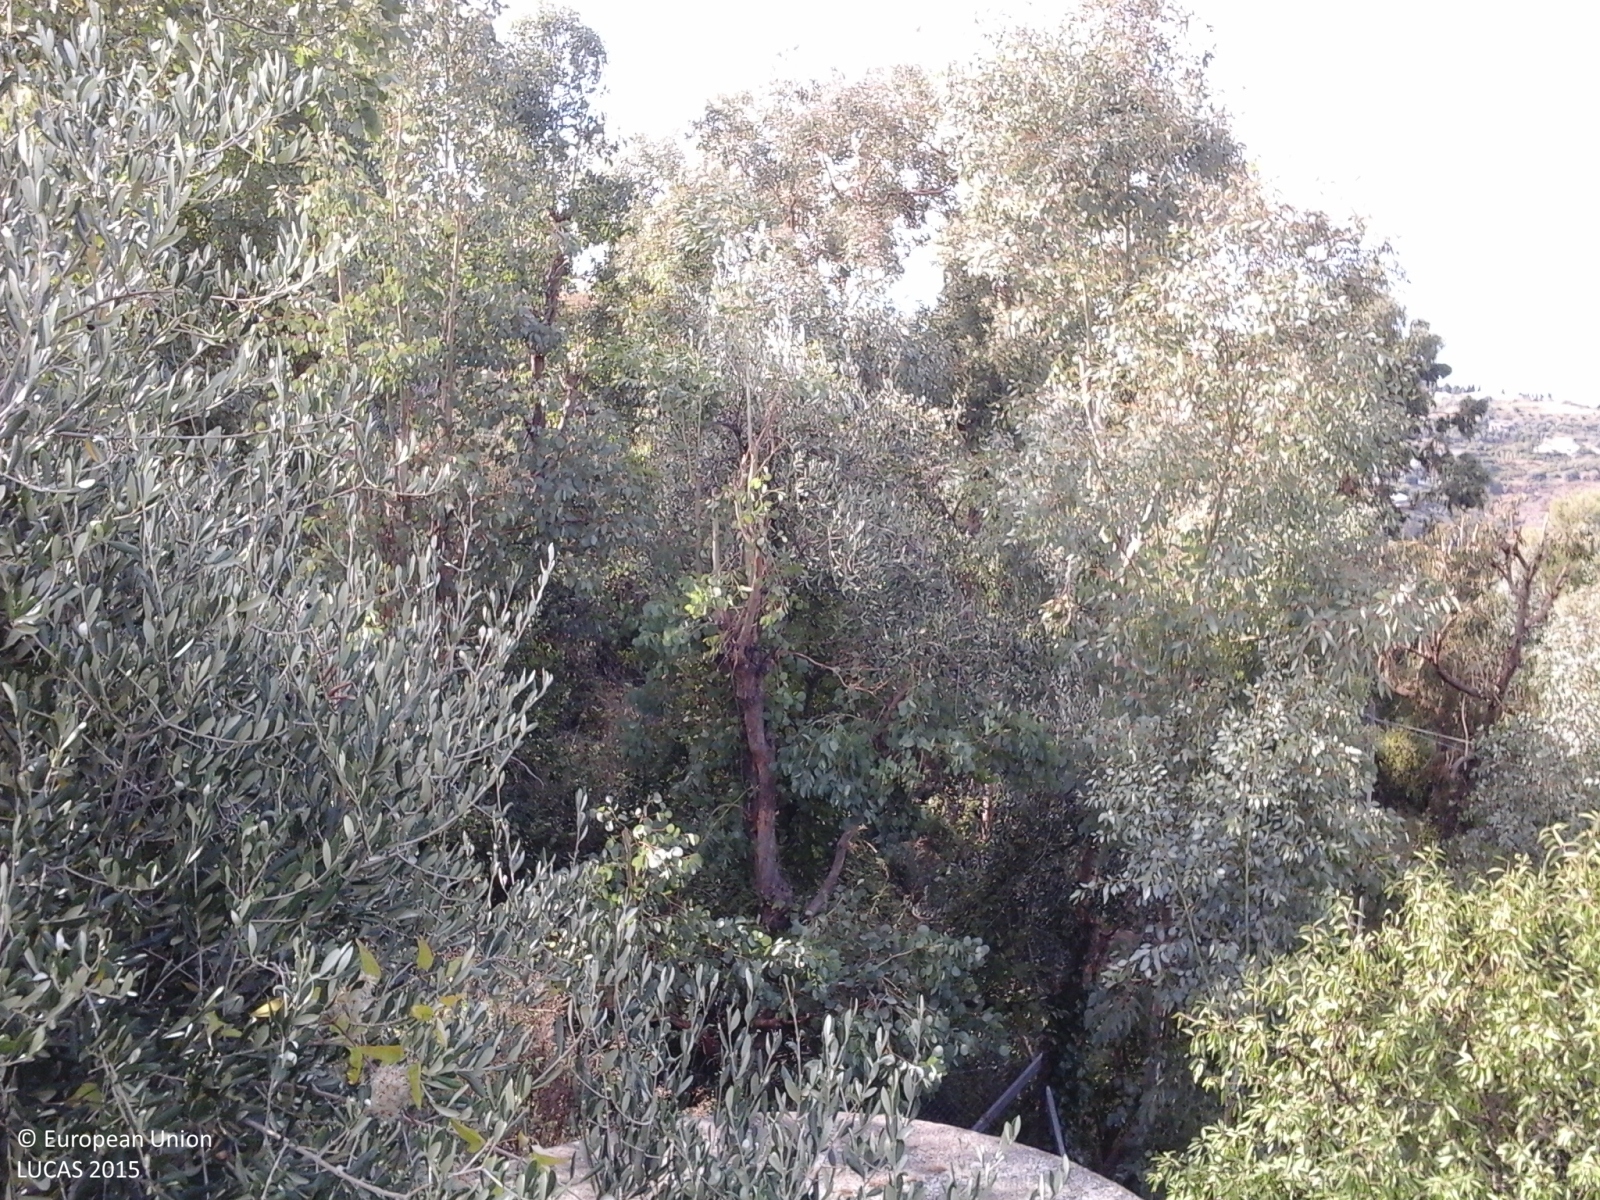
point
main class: Woodland
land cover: Broadleaved woodland
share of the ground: > 75 %
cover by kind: broadleaved forest trees 100 %
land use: Semi-natural and natural areas not in use
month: October
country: IT
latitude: 43.8406
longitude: 7.8288
